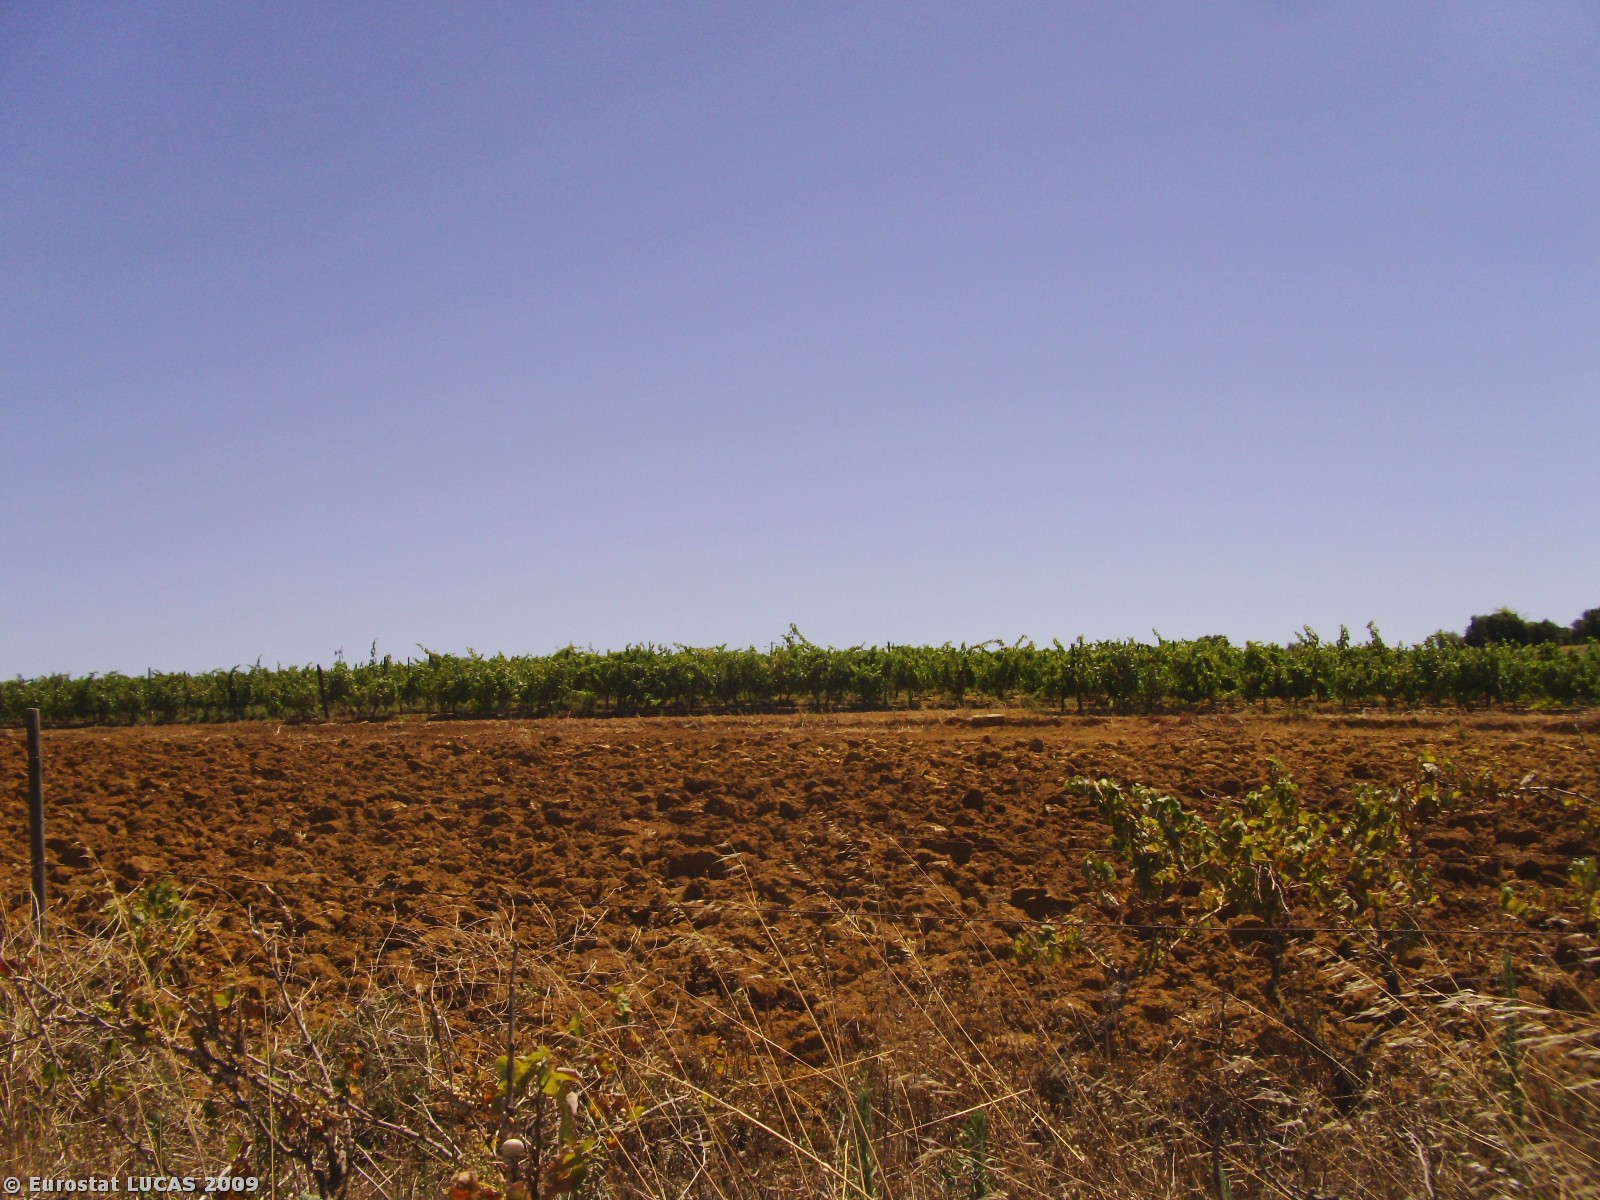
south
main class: Cropland
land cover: Vineyards
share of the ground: 25 - 50 %
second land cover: Spontaneously vegetated surfaces
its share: 25 - 50 %
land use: Fallow land
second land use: Unused
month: July
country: PT
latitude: 39.1254
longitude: -8.8485
